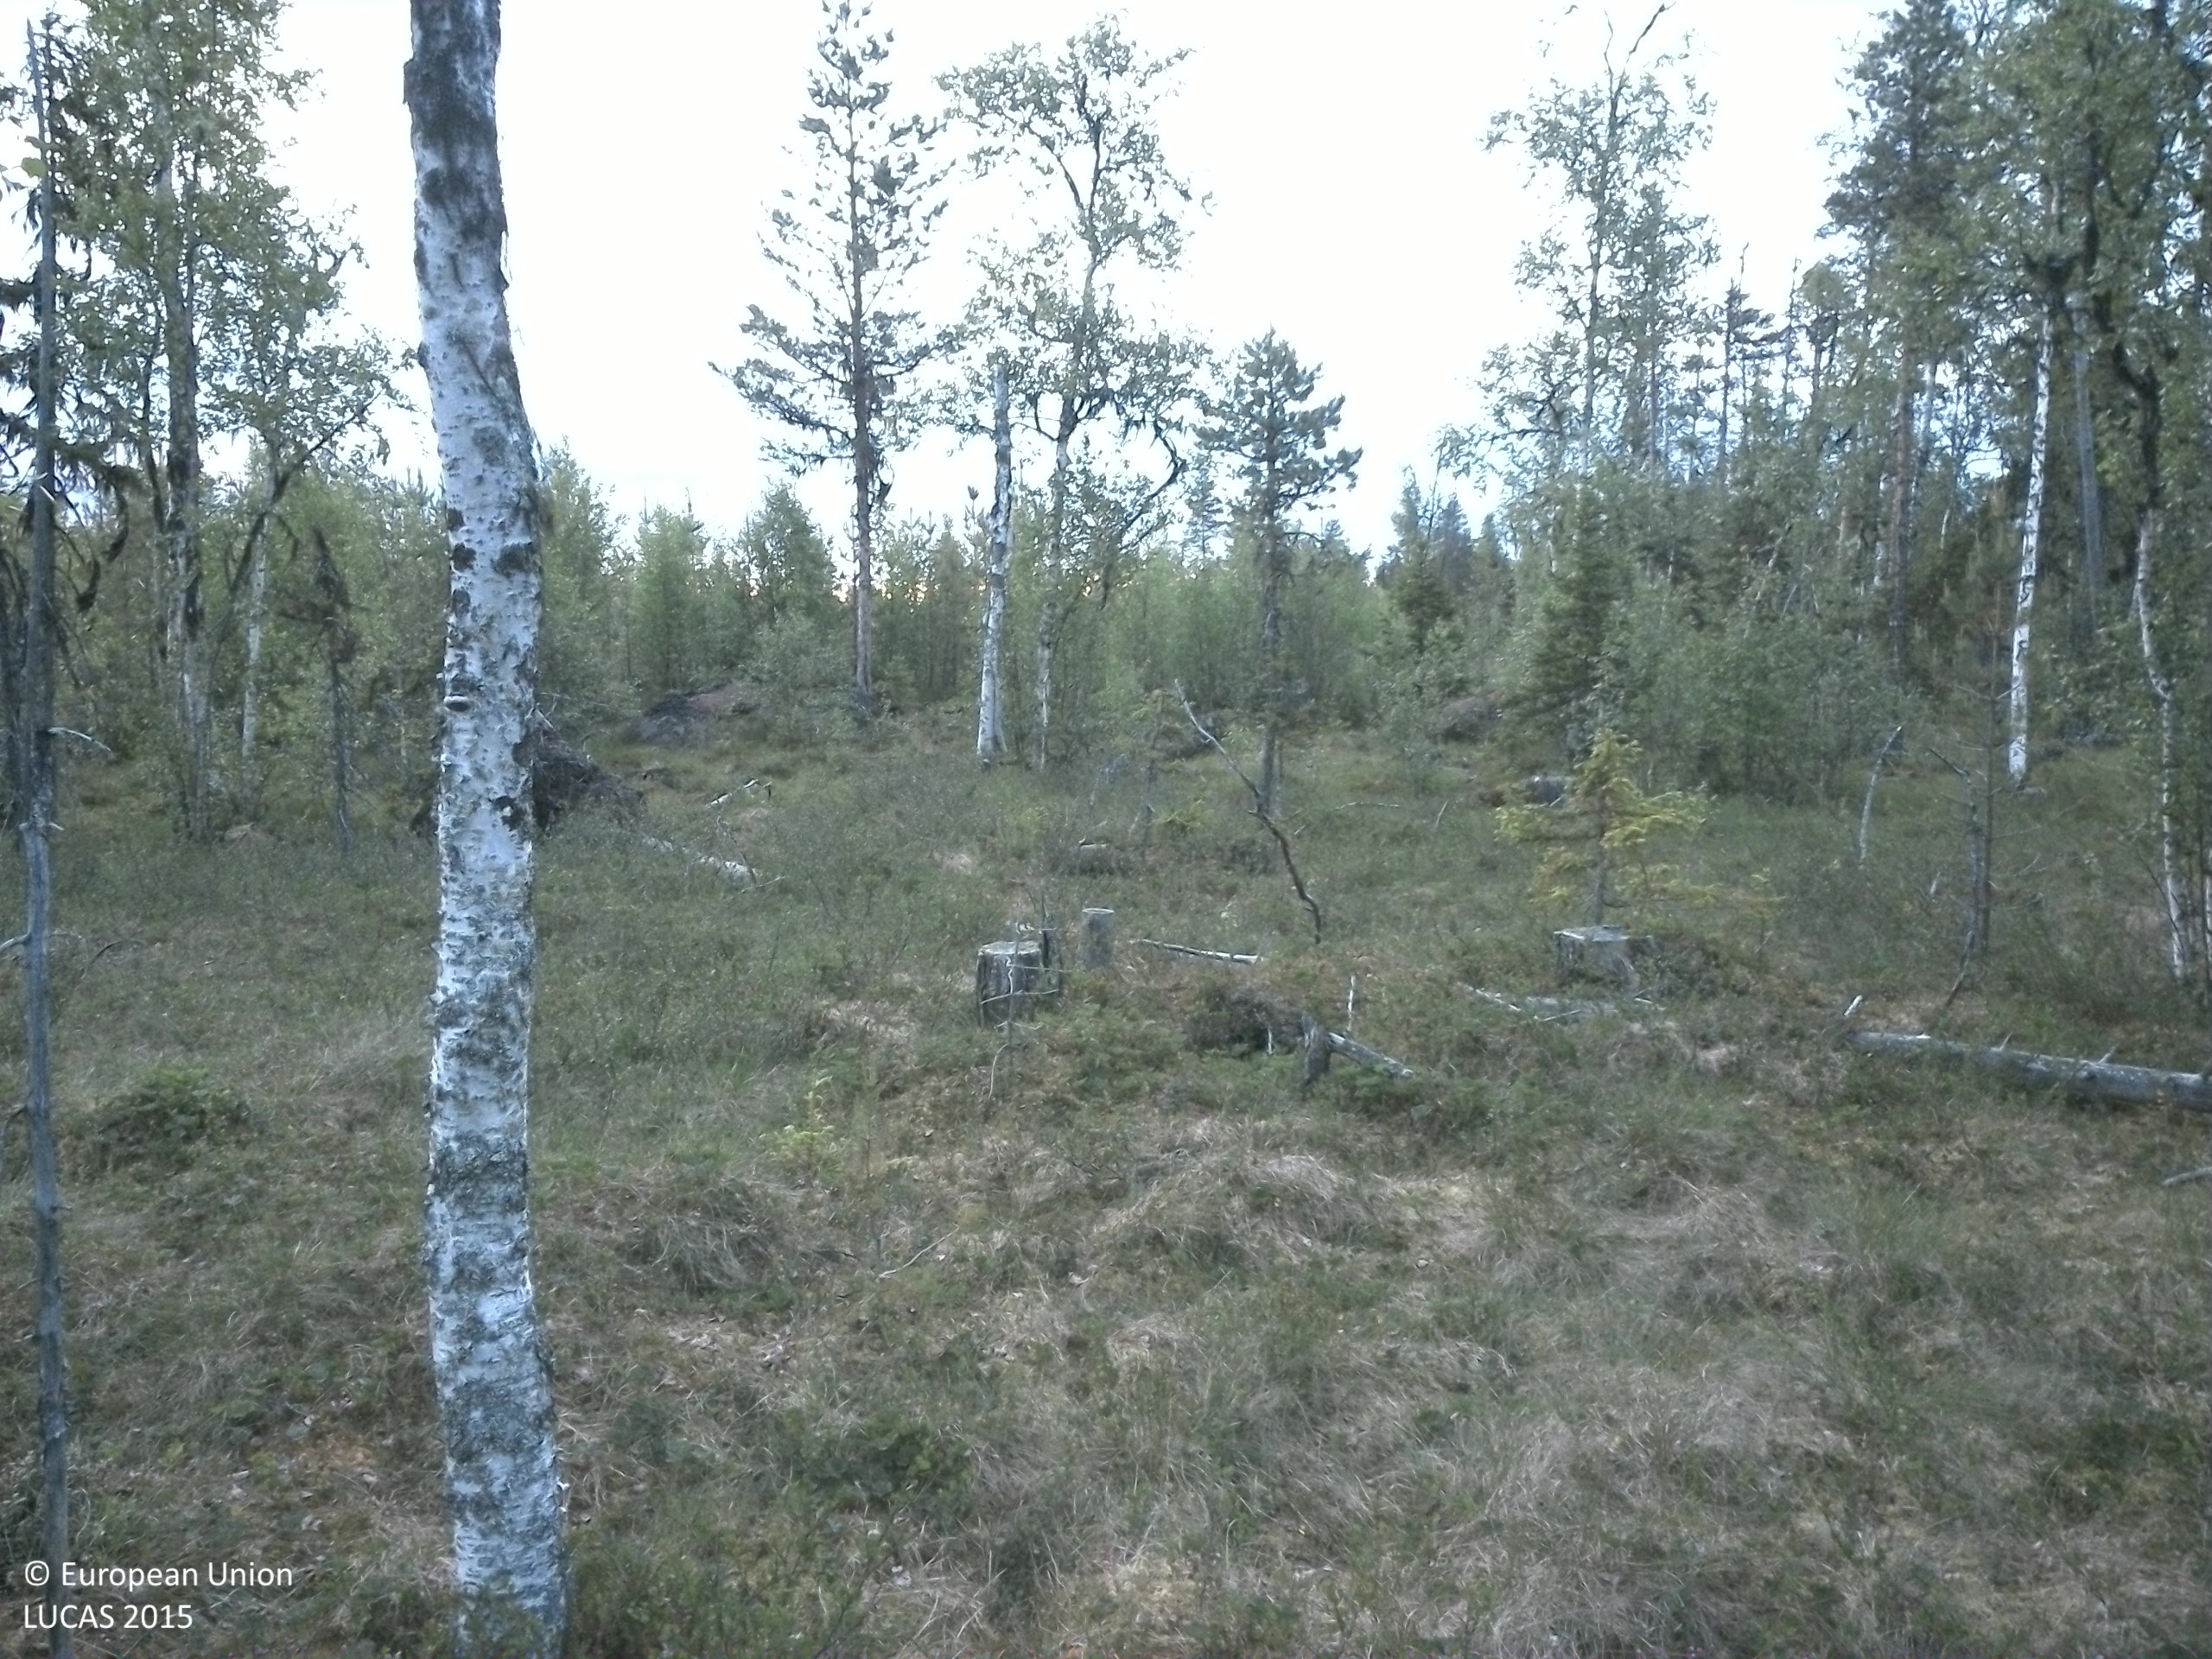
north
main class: Woodland
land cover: Pine dominated mixed woodland
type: boreal forest
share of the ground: 10 - 25 %
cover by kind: herbaceous plants 35 %, shrubs 25 %, coniferous forest trees 15 %, lichens and mosses 15 %, broadleaved forest trees 10 %
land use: Forestry
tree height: > 5 m
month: July
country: SE
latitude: 64.2824
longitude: 16.5166
